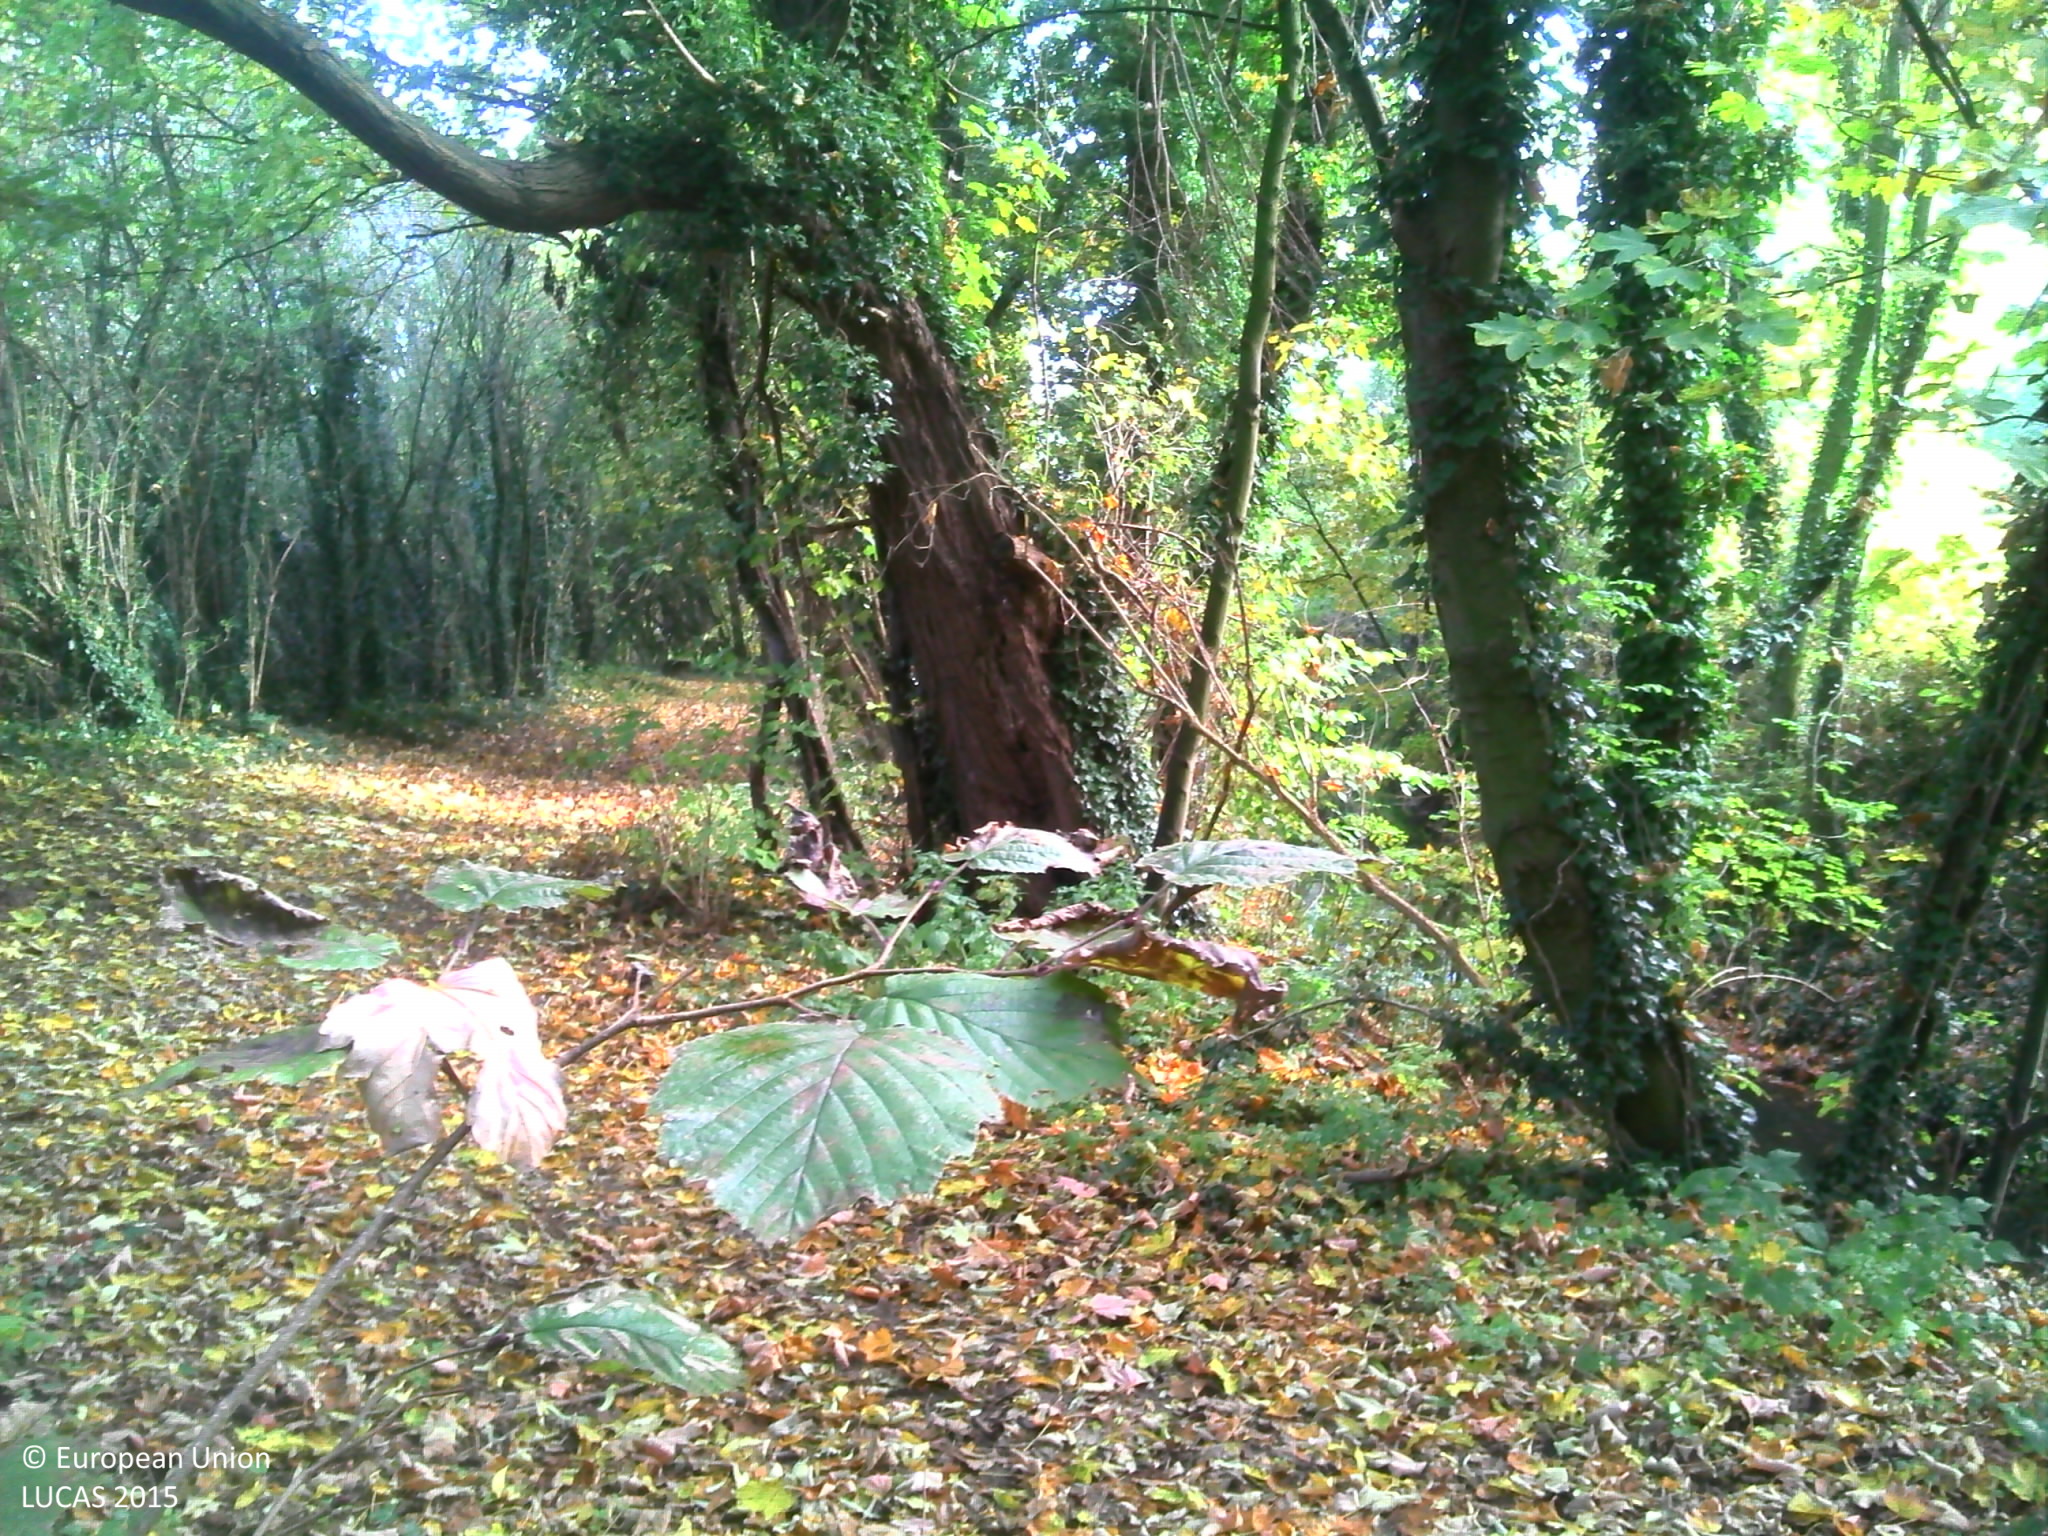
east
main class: Woodland
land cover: Broadleaved woodland
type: mesophytic deciduous forest
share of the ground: > 75 %
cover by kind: broadleaved forest trees 90 %, shrubs 5 %, herbaceous plants 5 %
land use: Amenities, museums, leisure
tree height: > 5 m
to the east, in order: Broadleaved woodland; Tracks; Broadleaved woodland; Inland fresh running water; Broadleaved woodland; Grassland without tree/shrub cover; Artificial constructions in urban areas
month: October
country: BE
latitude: 50.8790
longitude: 4.4669
